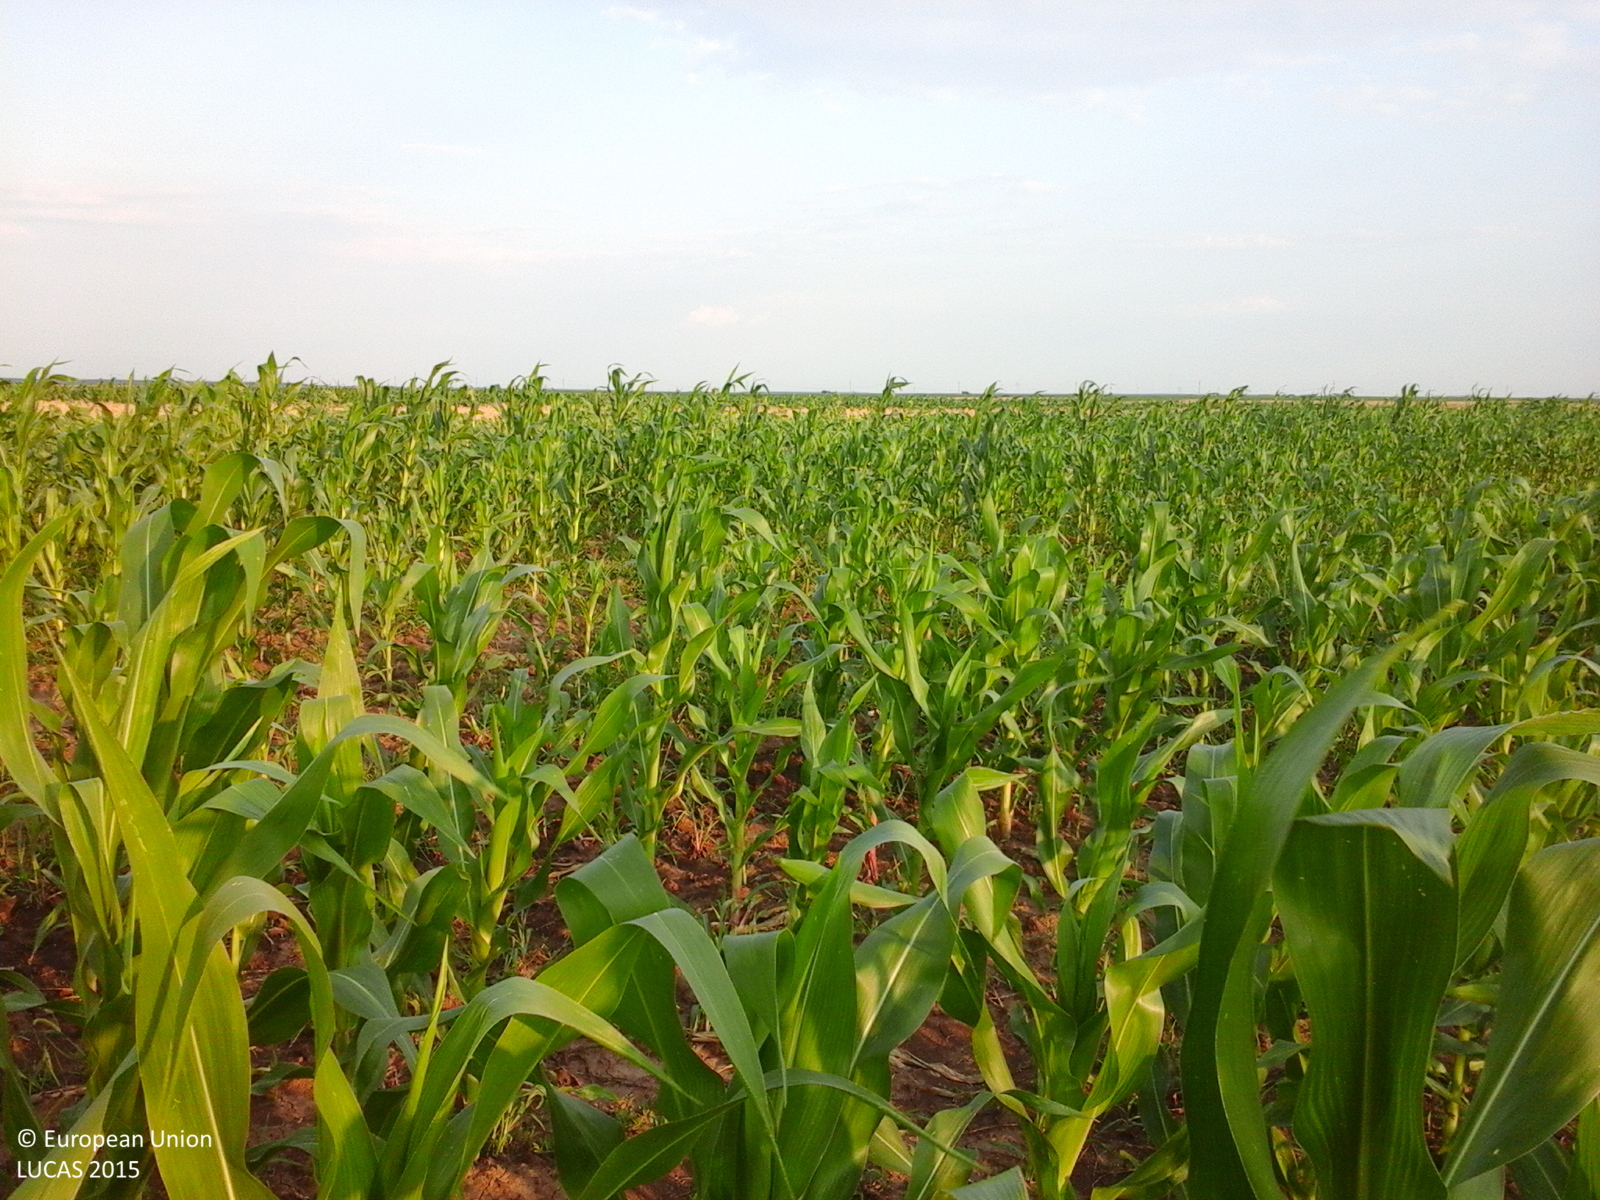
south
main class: Cropland
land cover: Maize
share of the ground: 50 - 75 %
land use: Agriculture (excluding fallow land and kitchen gardens)
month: July
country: RO
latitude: 44.2822
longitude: 25.5918
